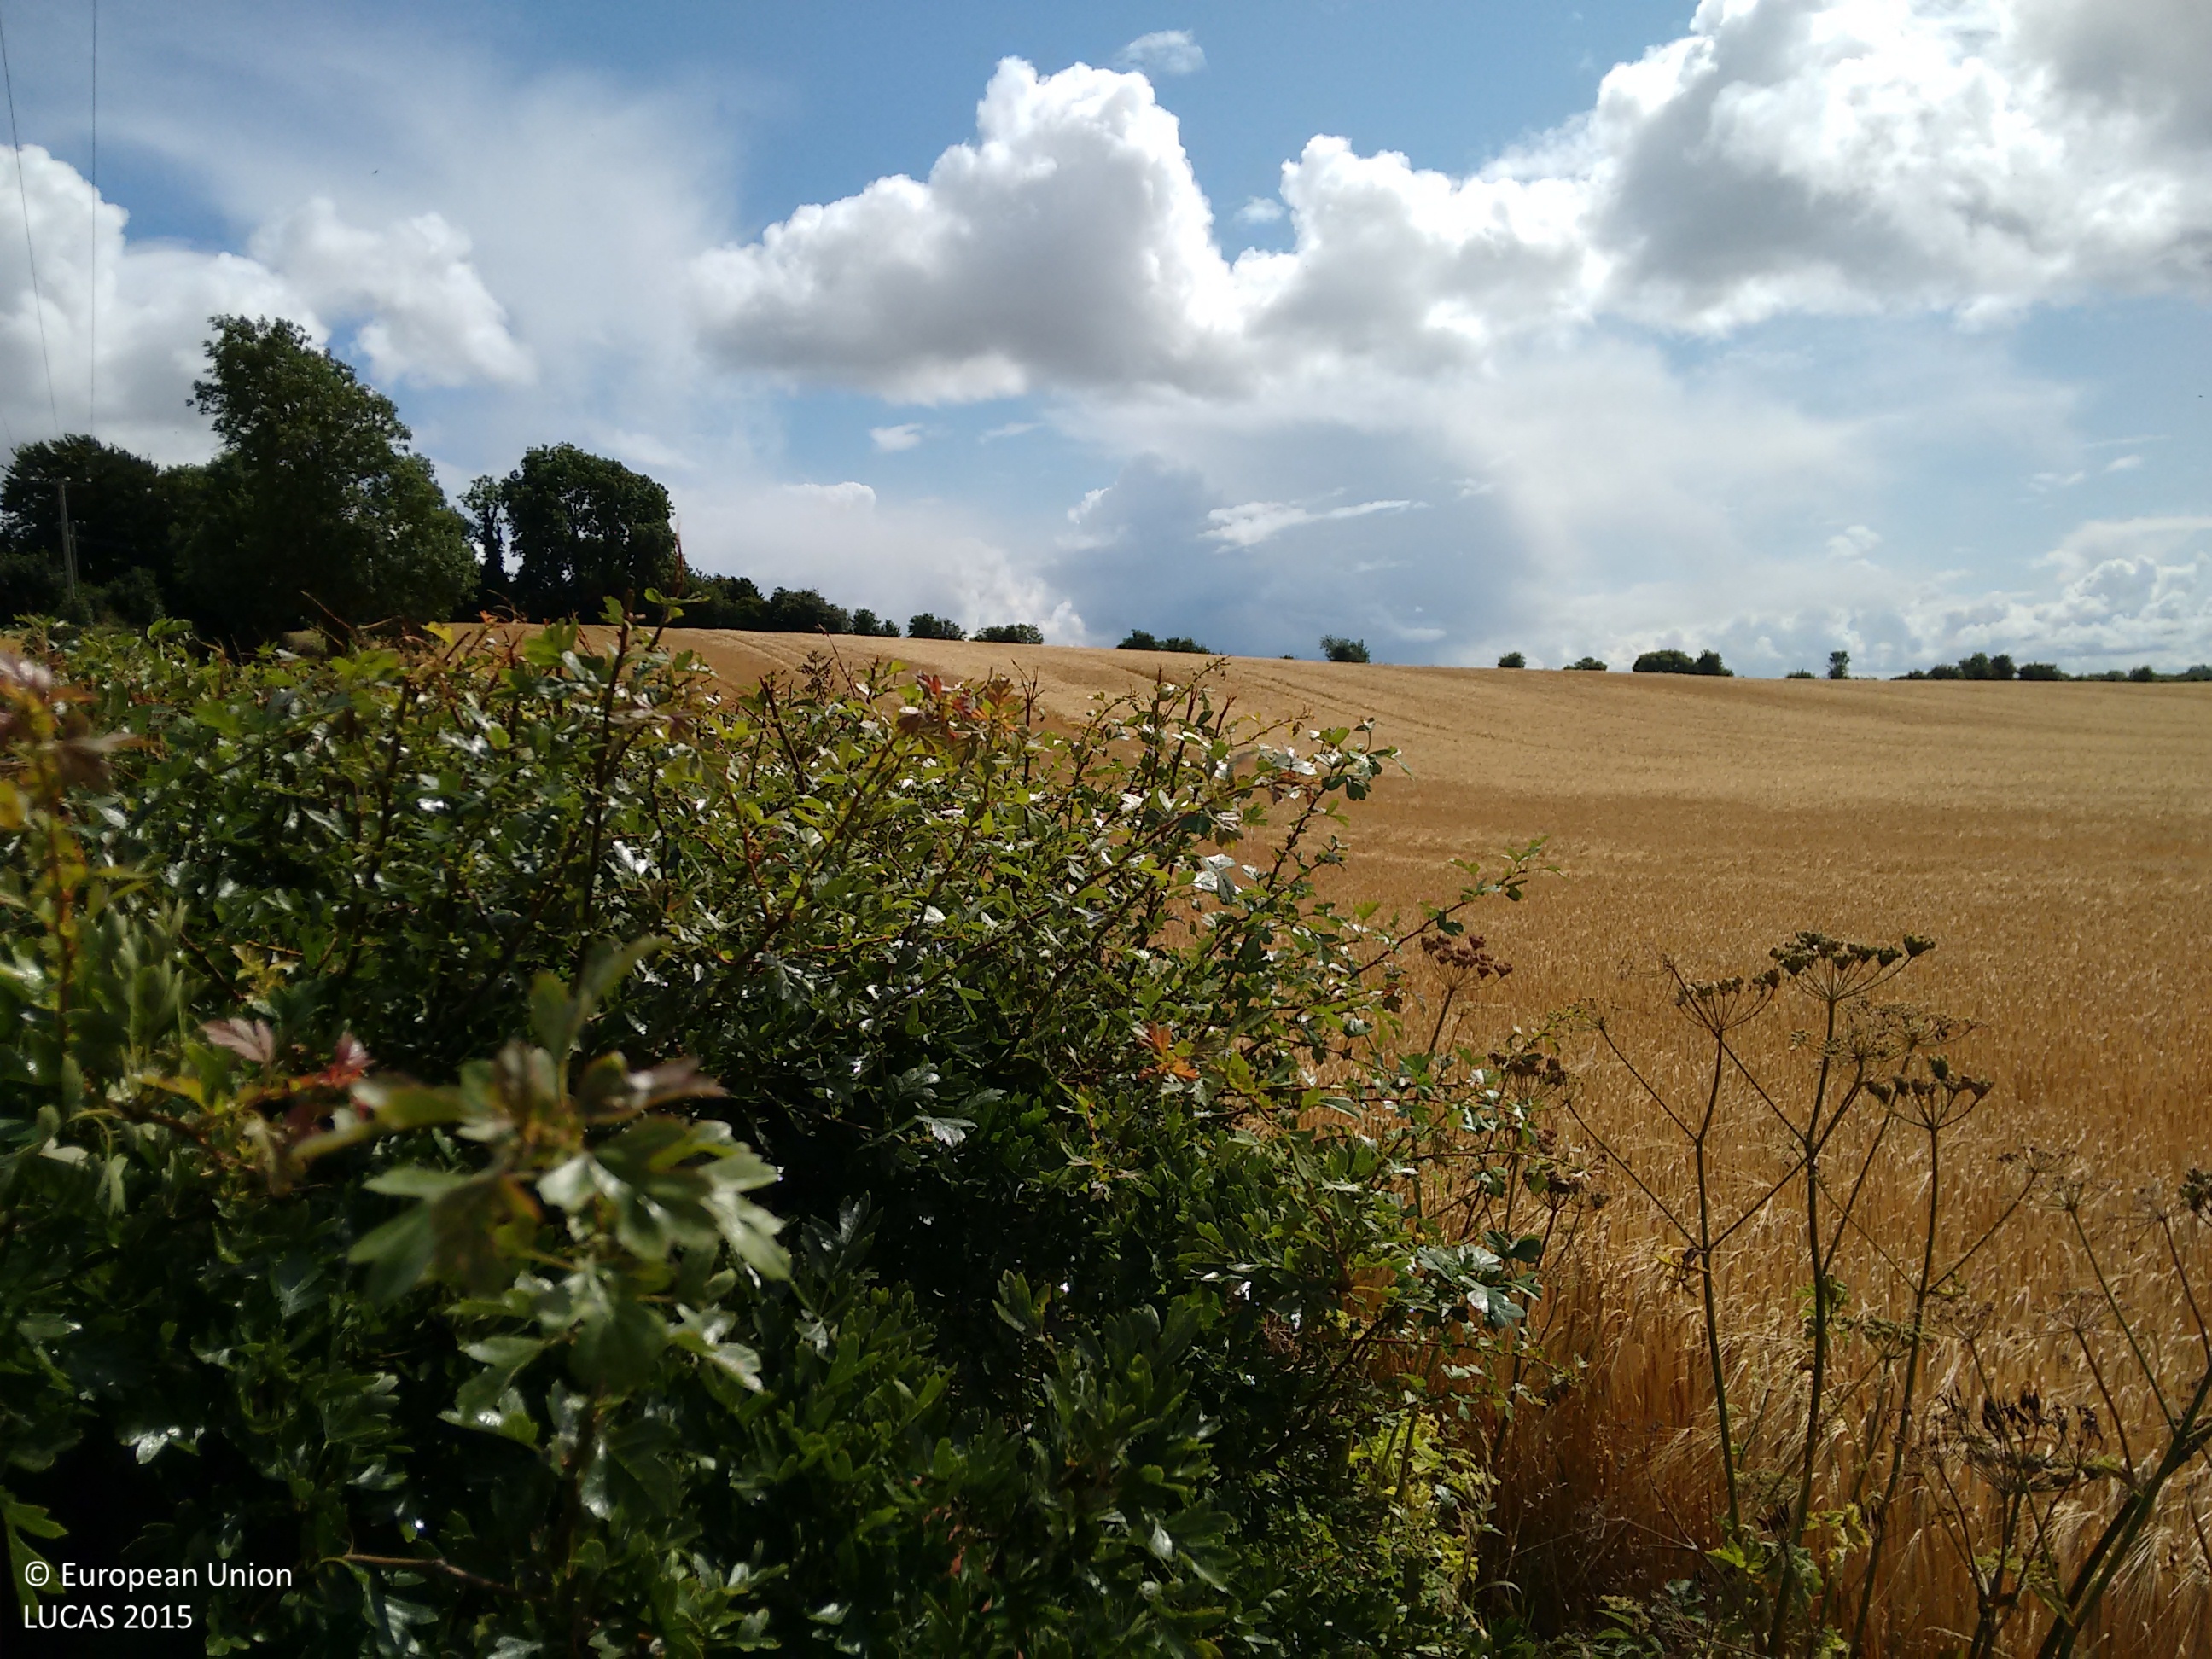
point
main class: Cropland
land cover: Barley
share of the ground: > 75 %
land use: Agriculture (excluding fallow land and kitchen gardens)
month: July
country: IE
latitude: 52.7917
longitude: -6.7588
